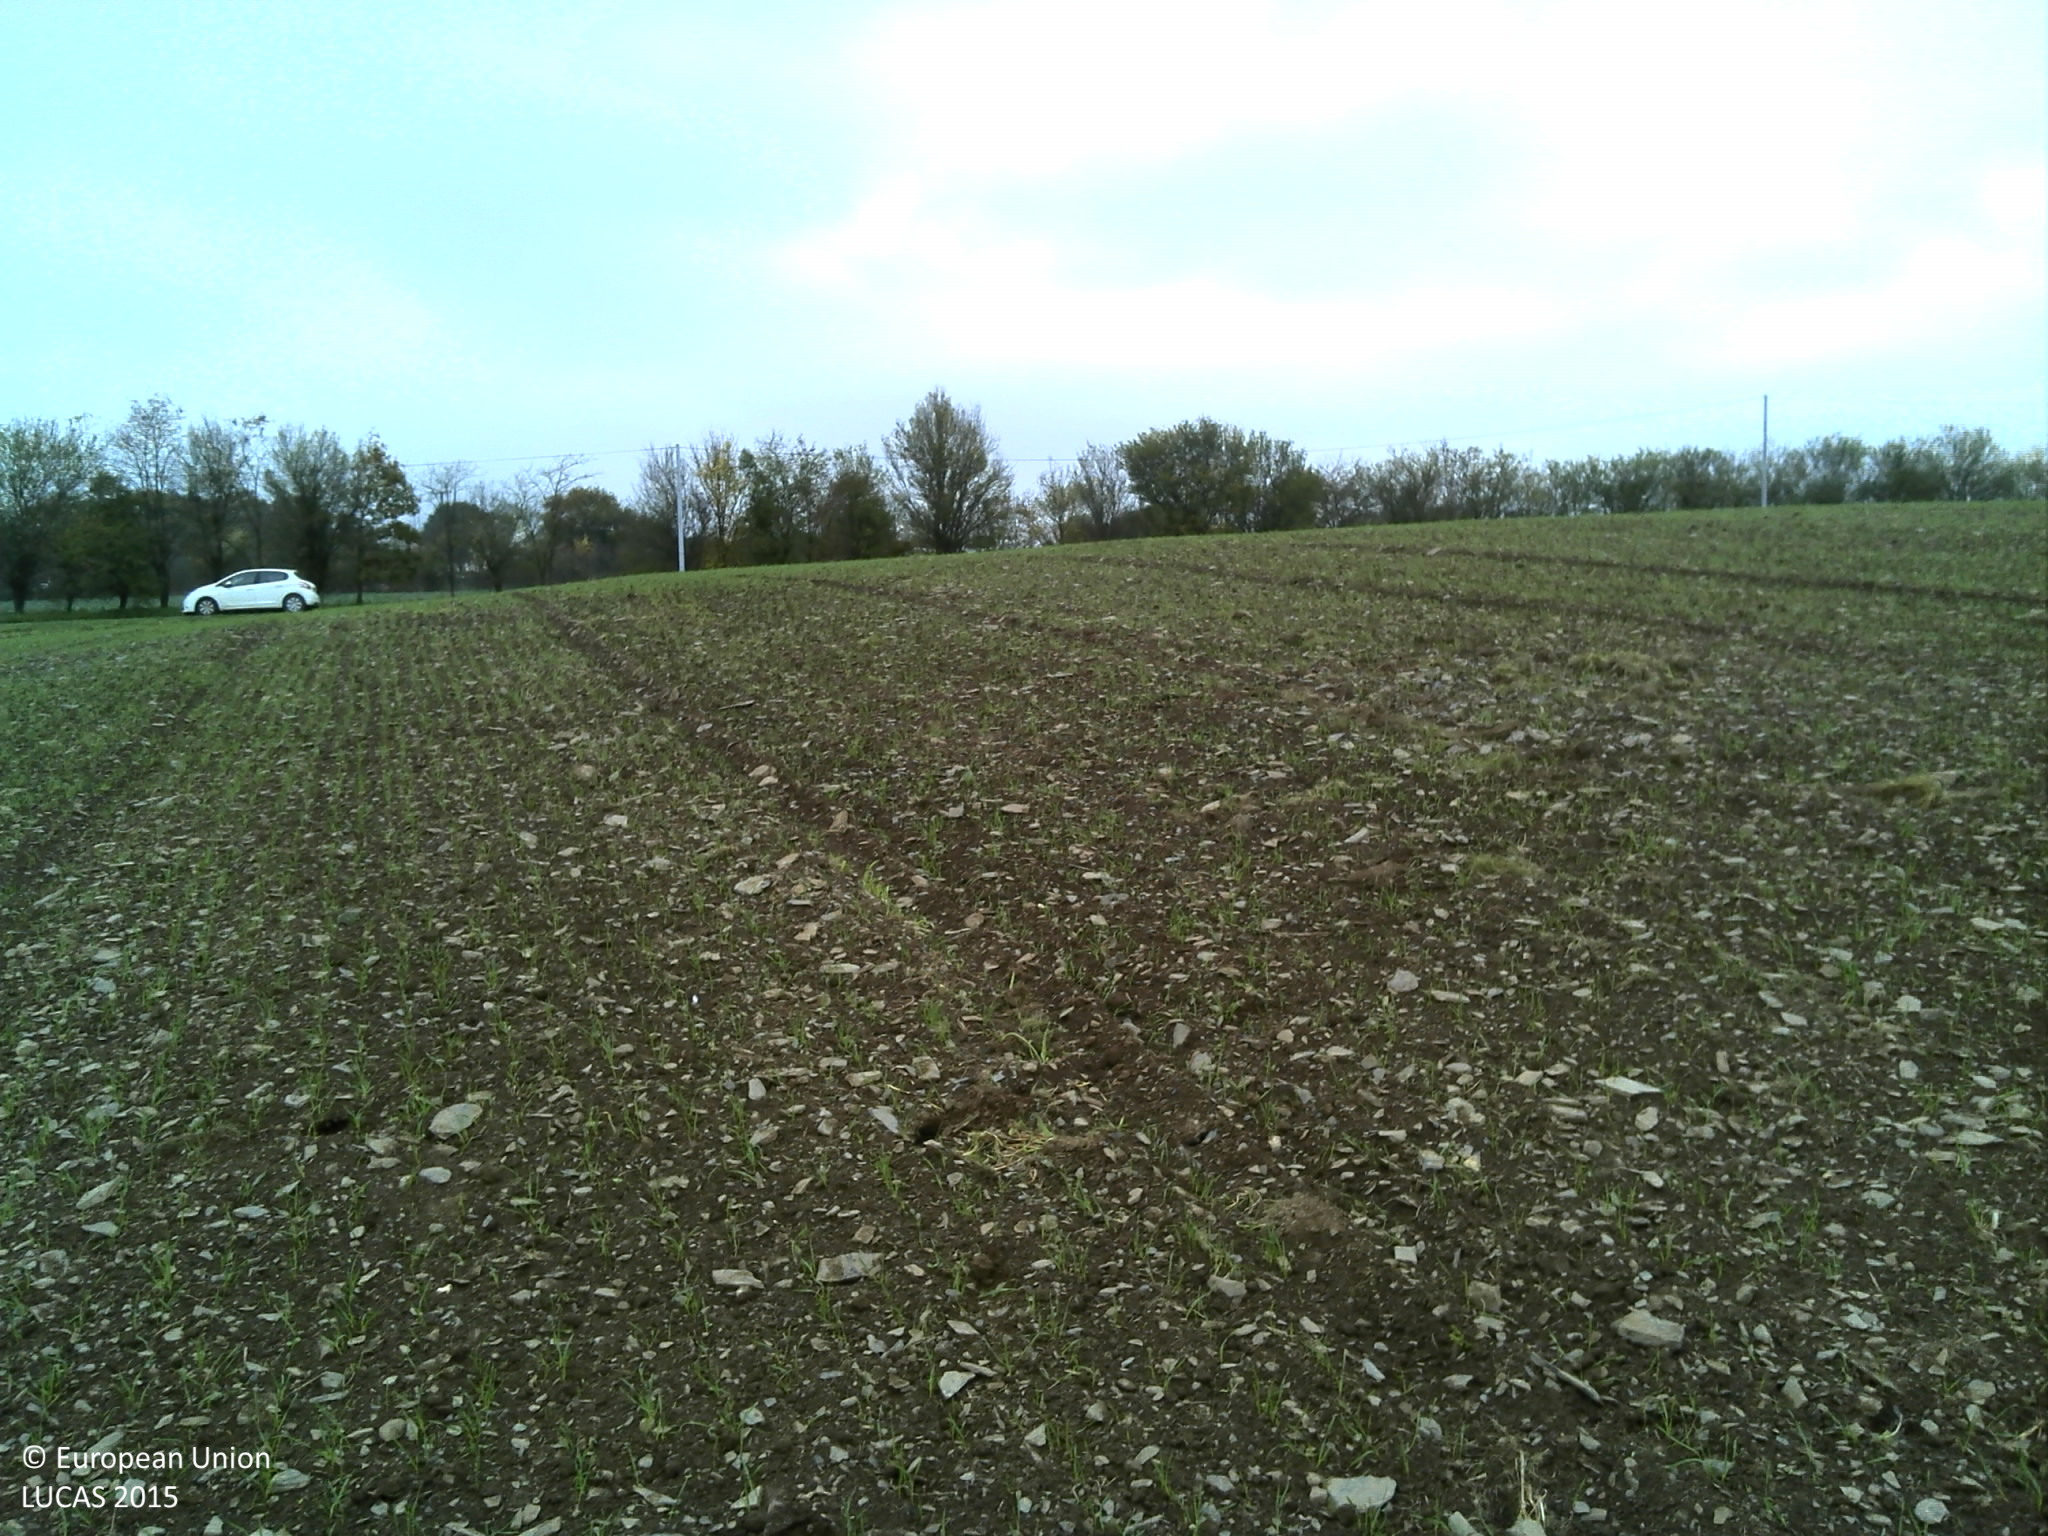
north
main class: Cropland
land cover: Common wheat
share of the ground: < 10 %
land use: Agriculture (excluding fallow land and kitchen gardens)
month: November
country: FR
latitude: 47.6157
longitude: -1.3636
